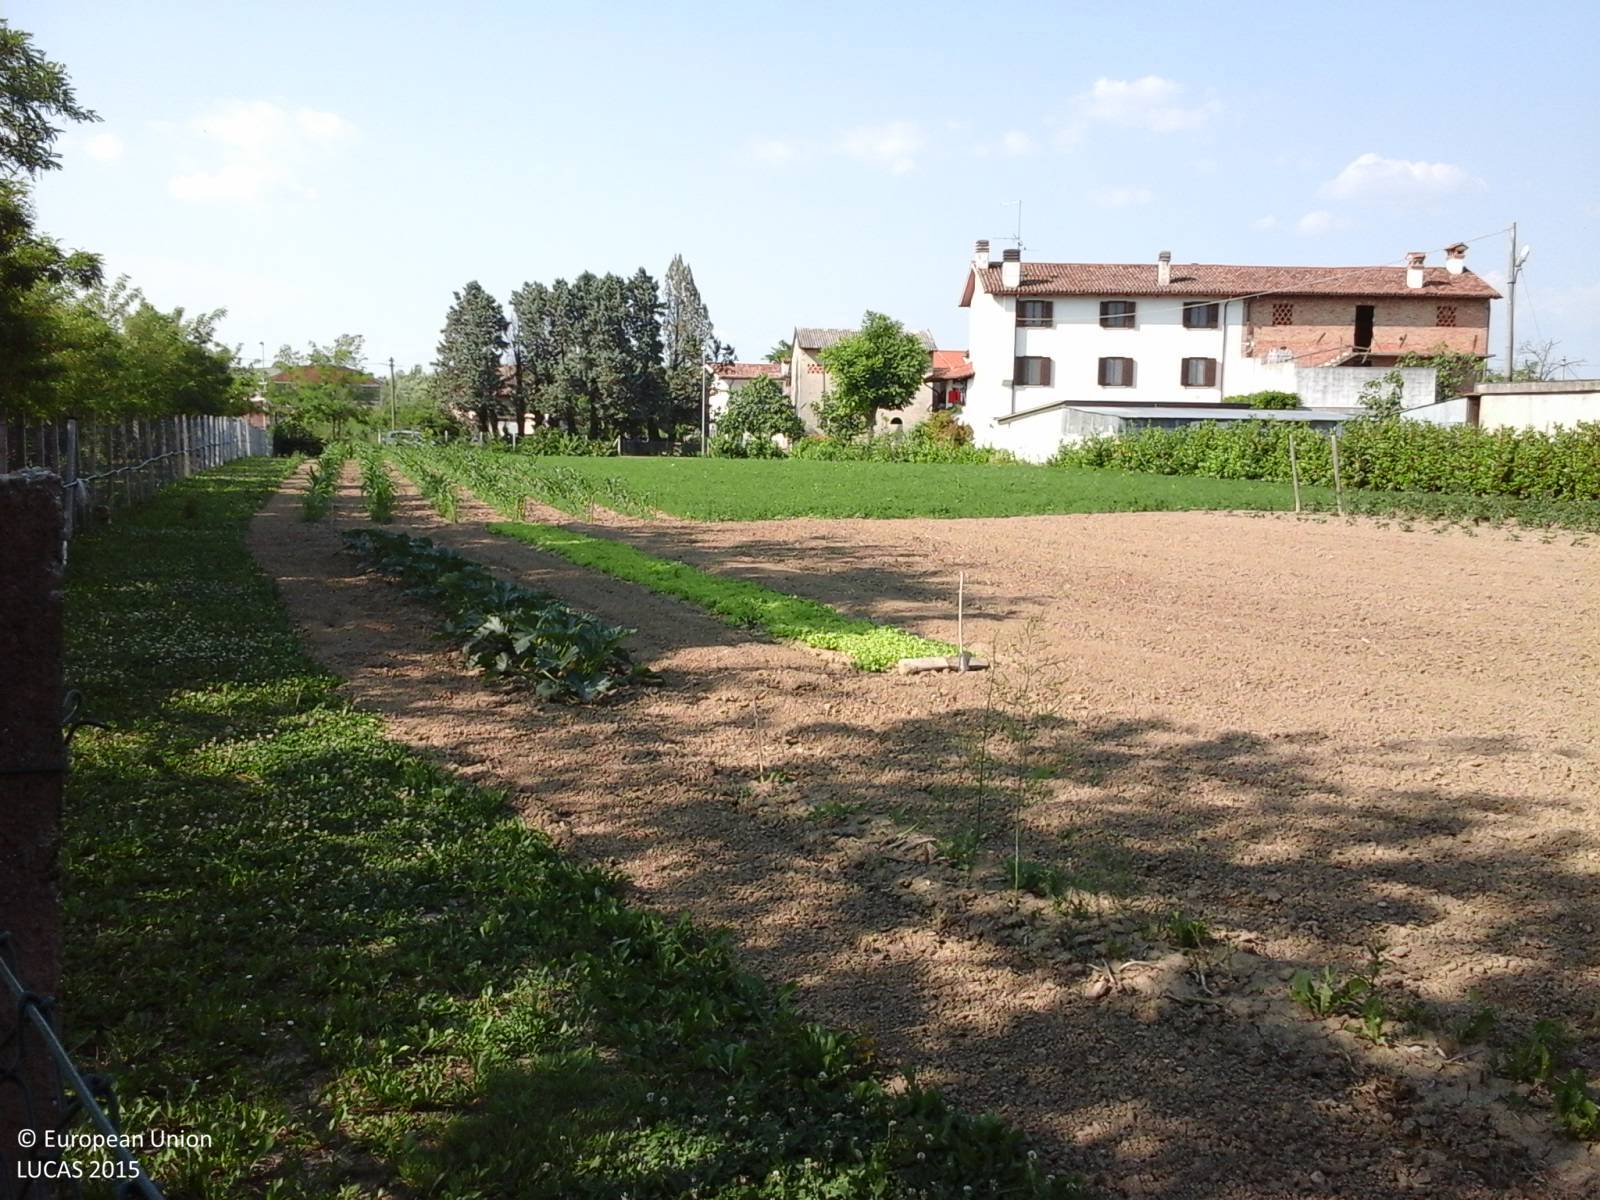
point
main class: Cropland
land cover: Other fresh vegetables
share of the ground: 50 - 75 %
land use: Kitchen garden
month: June
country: IT
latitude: 45.8290
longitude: 13.3816
